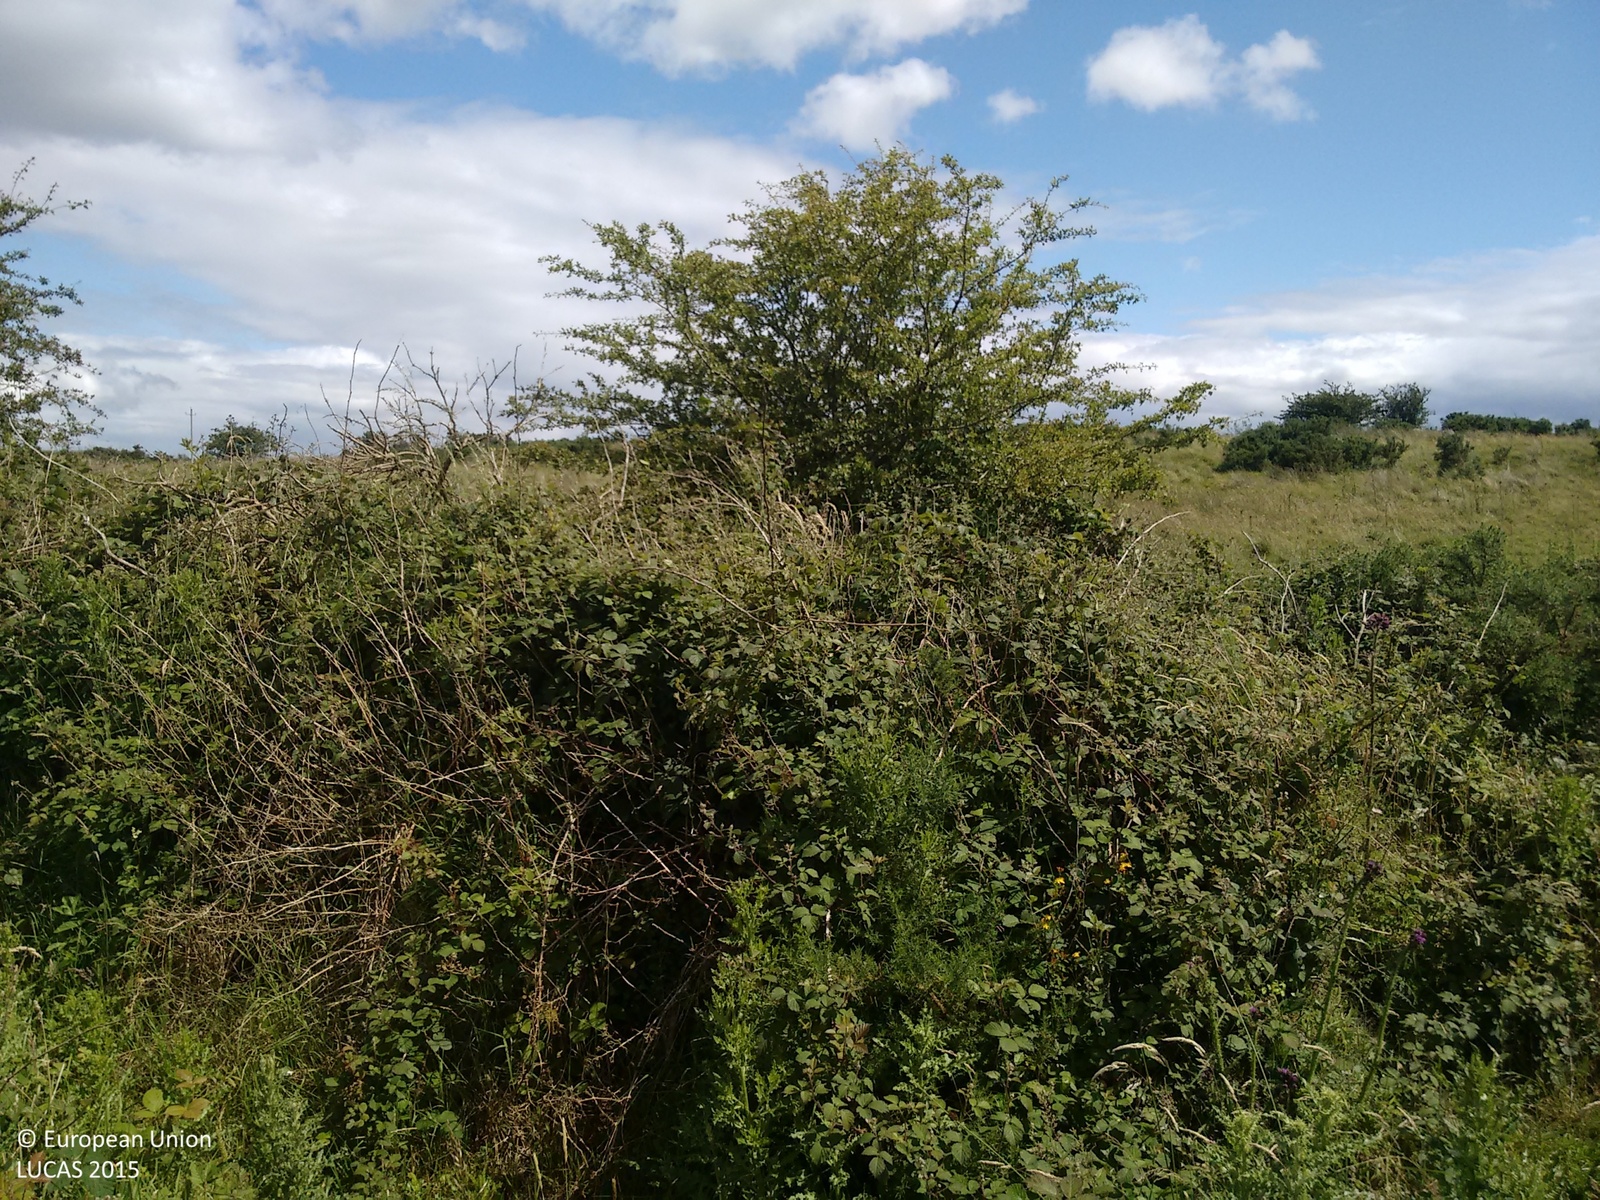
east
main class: Grassland
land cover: Grassland with sparse tree/shrub cover
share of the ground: 50 - 75 %
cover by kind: herbaceous plants 85 %, shrubs 10 %, broadleaved forest trees 5 %
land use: Agriculture (excluding fallow land and kitchen gardens)
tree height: < 5 m
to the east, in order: Grassland with sparse tree/shrub cover; Shrubland without tree cover; Fences; Shrubland without tree cover; Grassland without tree/shrub cover; Shrubland without tree cover; Dry stone walls; Fences; Shrubland without tree cover; Grassland without tree/shrub cover; Abandoned hedges; Grassland without tree/shrub cover; Abandoned hedges; Grassland without tree/shrub cover
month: July
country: IE
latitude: 53.6925
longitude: -8.7541
